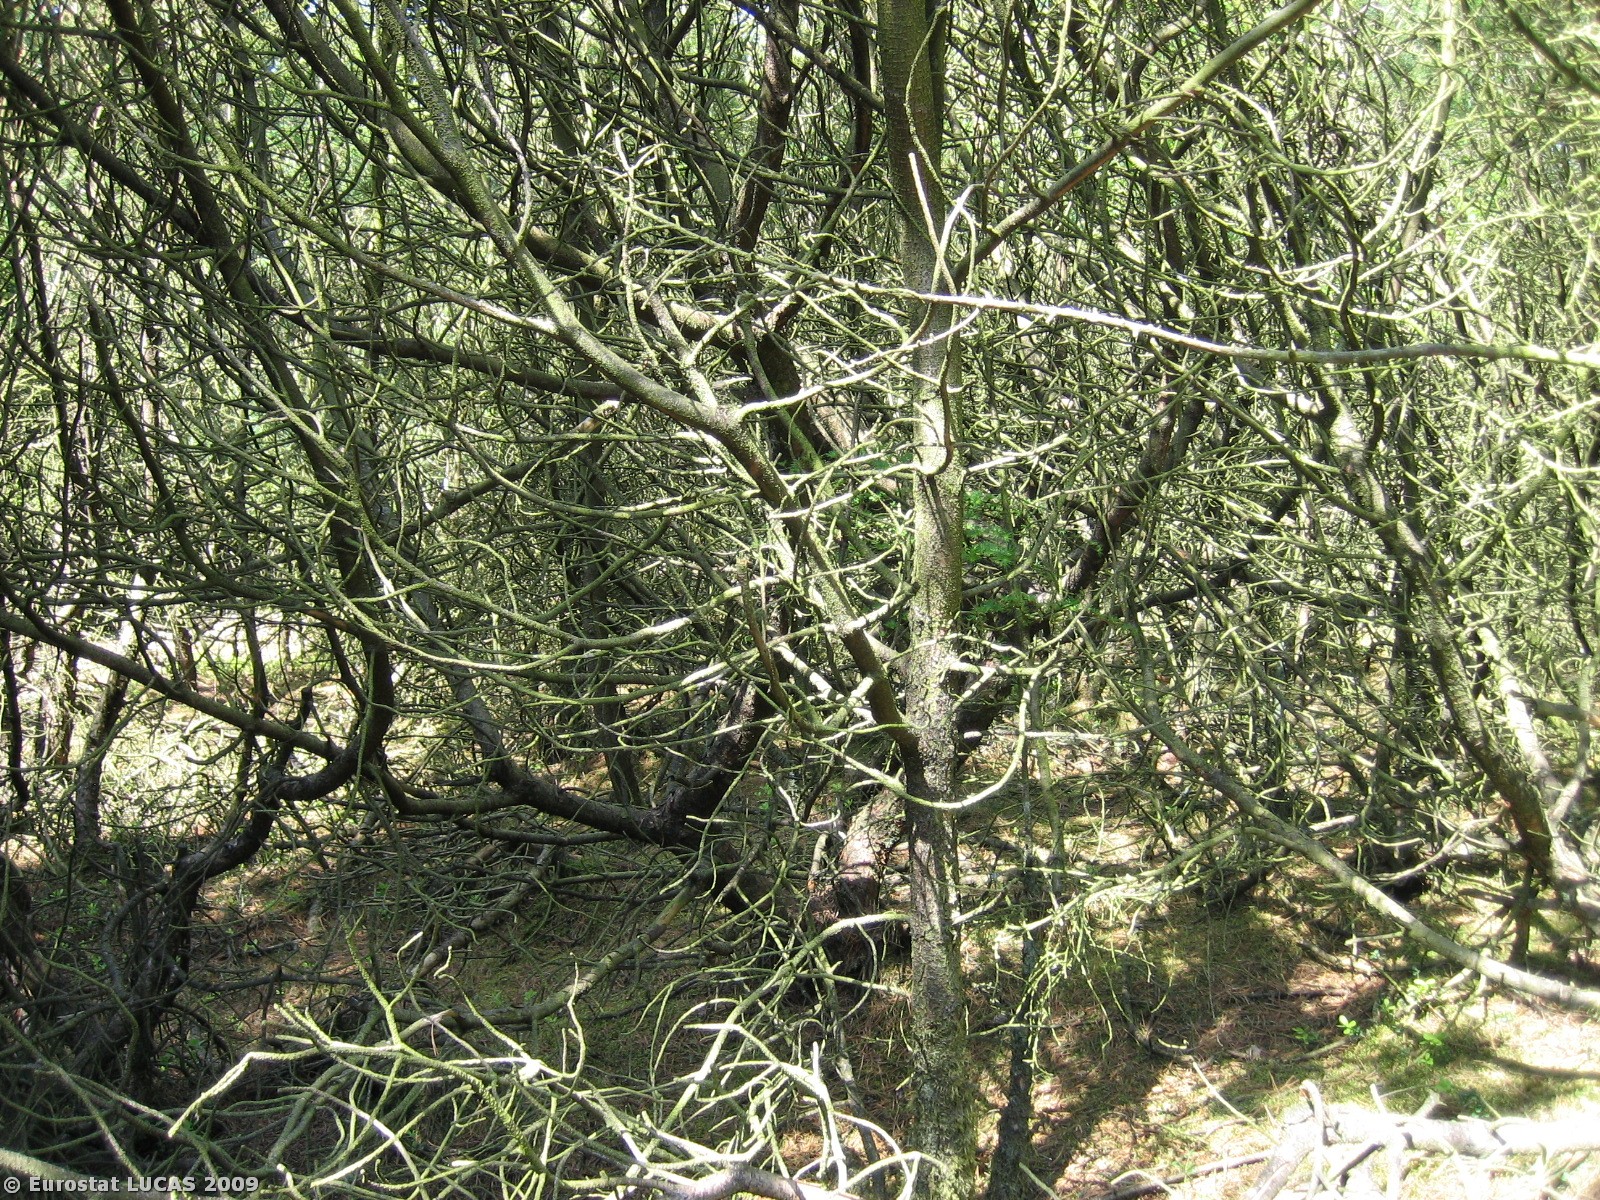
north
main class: Woodland
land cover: Coniferous woodland
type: hemiboreal forest and nemoral coniferous forest and mixed broadleaved-coniferous forest
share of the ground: > 75 %
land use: Forestry
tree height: > 5 m
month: May
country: DK
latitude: 56.2546
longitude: 8.8553
